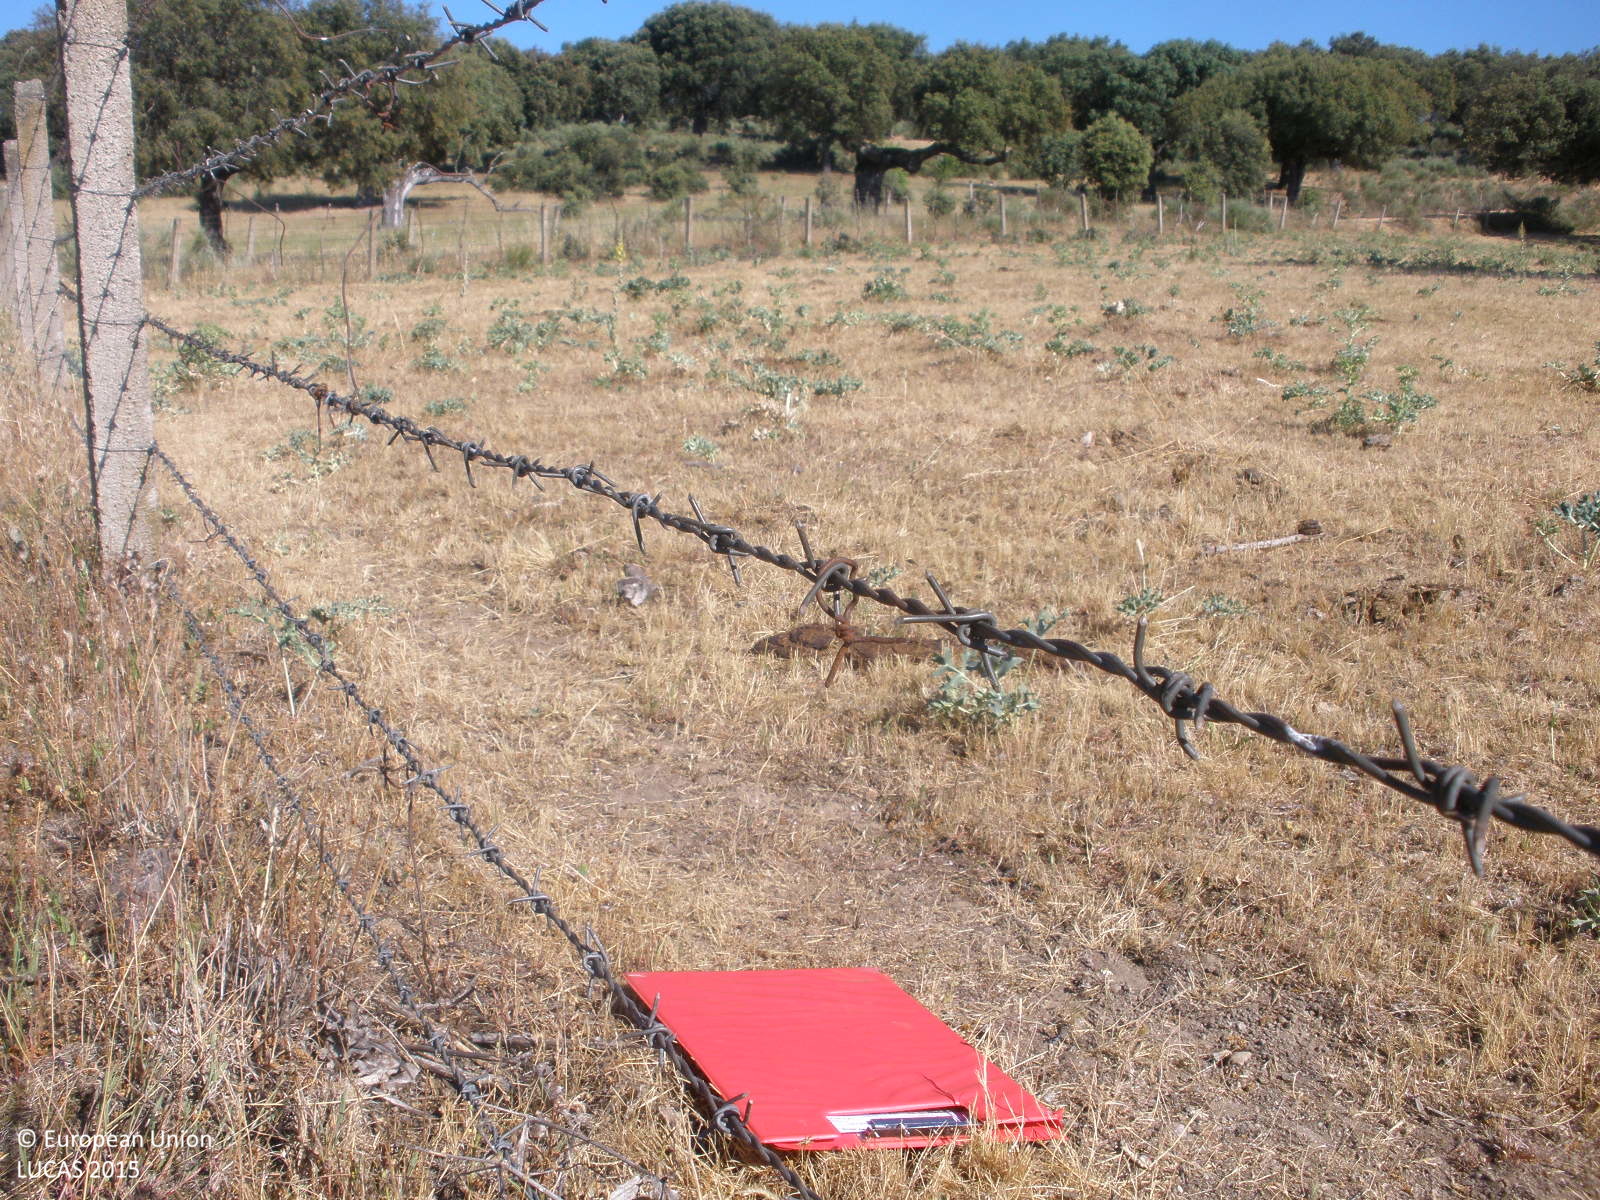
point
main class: Grassland
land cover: Grassland with sparse tree/shrub cover
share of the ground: > 75 %
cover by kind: herbaceous plants 95 %, broadleaved forest trees 5 %
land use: Agriculture (excluding fallow land and kitchen gardens)
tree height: > 5 m
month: June
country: ES
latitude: 40.5276
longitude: -6.6532
